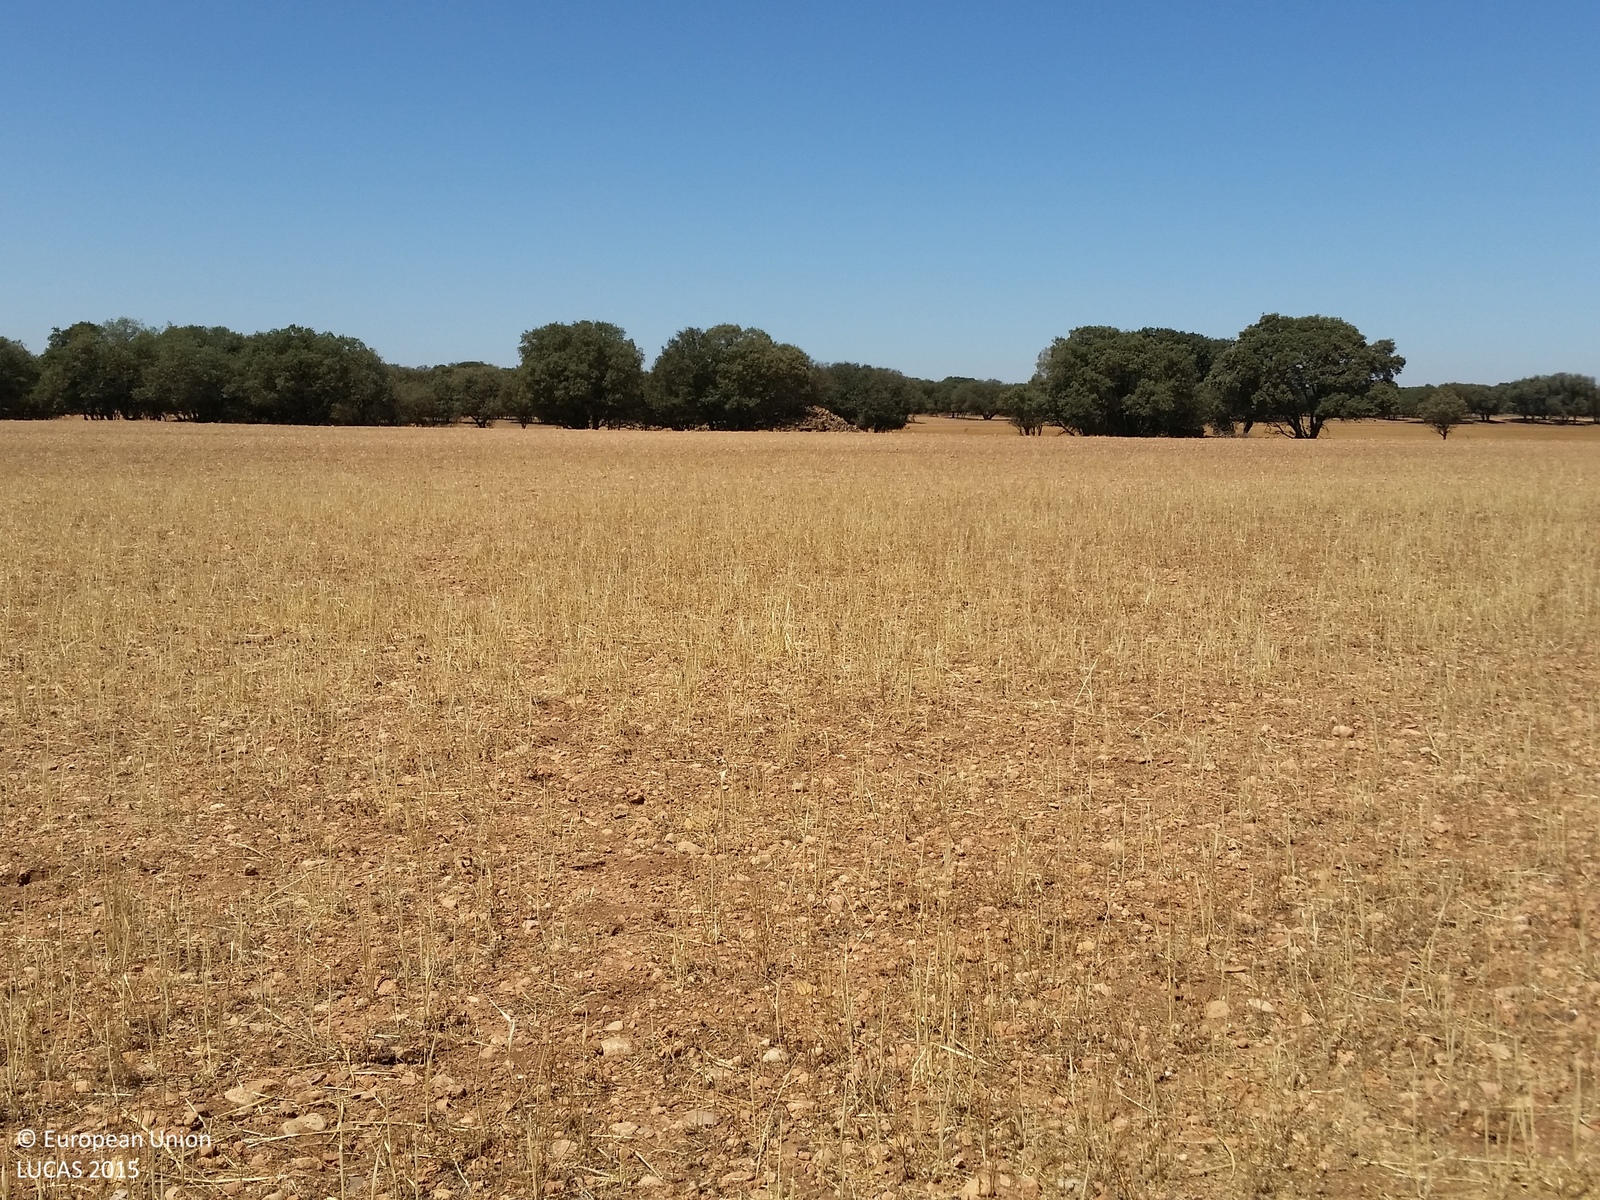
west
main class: Cropland
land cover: Barley
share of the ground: < 10 %
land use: Agriculture (excluding fallow land and kitchen gardens)
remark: Harvested field
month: July
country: ES
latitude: 39.2137
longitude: -2.7388
